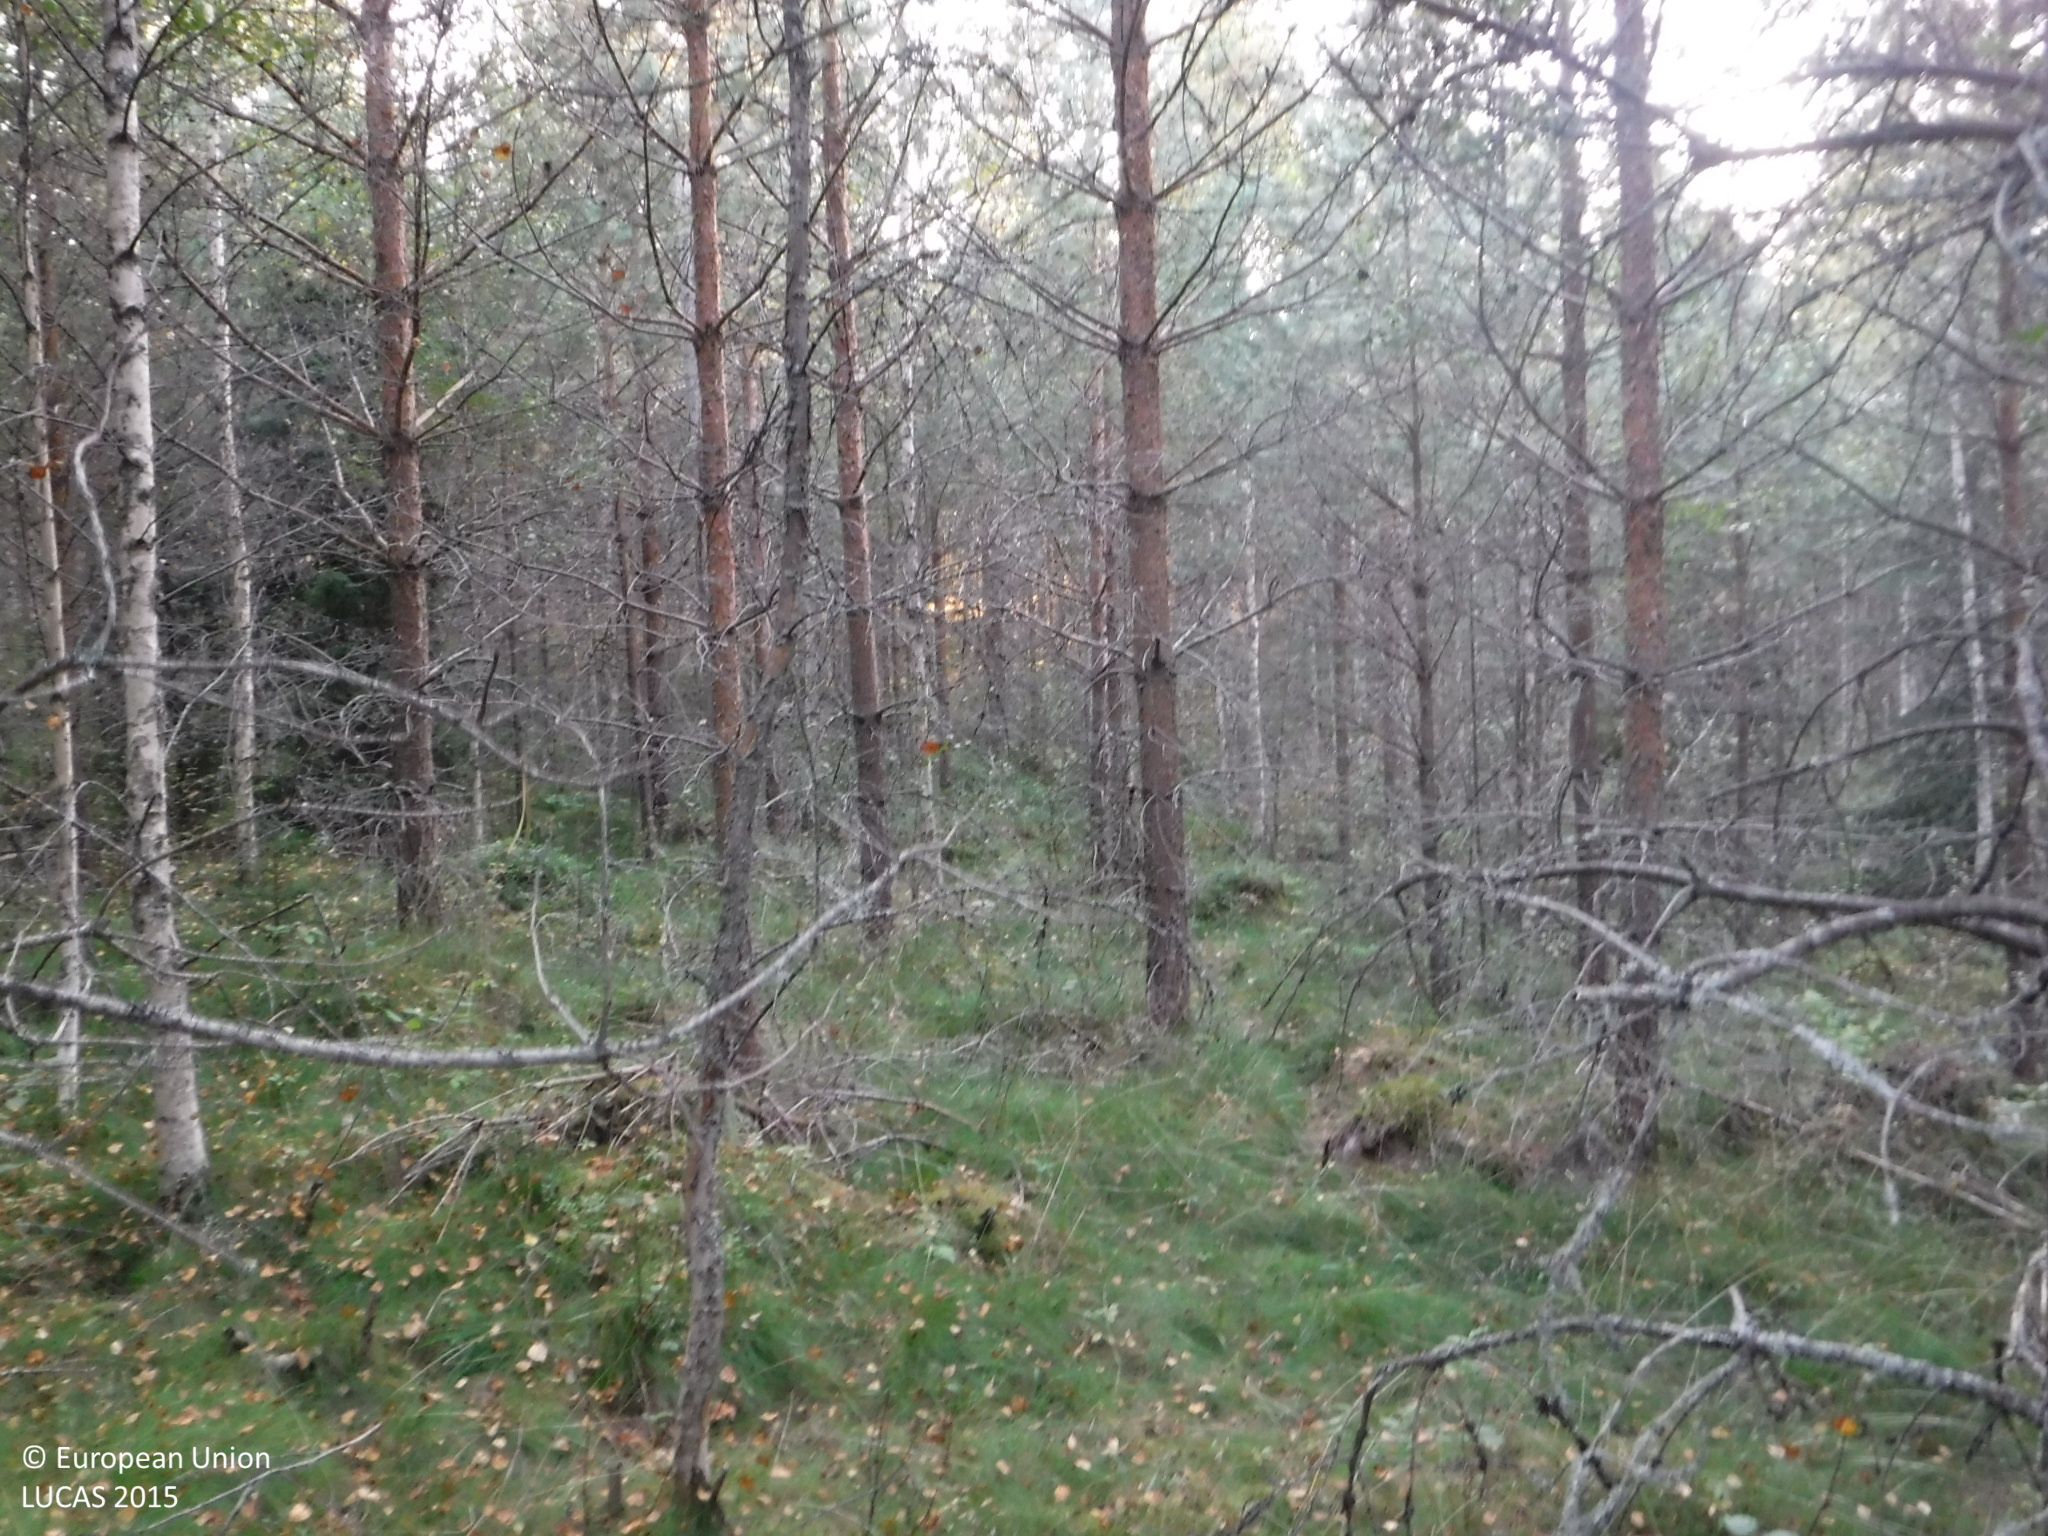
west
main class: Woodland
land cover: Pine dominated mixed woodland
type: boreal forest
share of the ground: > 75 %
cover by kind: coniferous forest trees 40 %, broadleaved forest trees 40 %, herbaceous plants 20 %
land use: Forestry
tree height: > 5 m
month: August
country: FI
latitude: 61.1467
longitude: 23.0218
